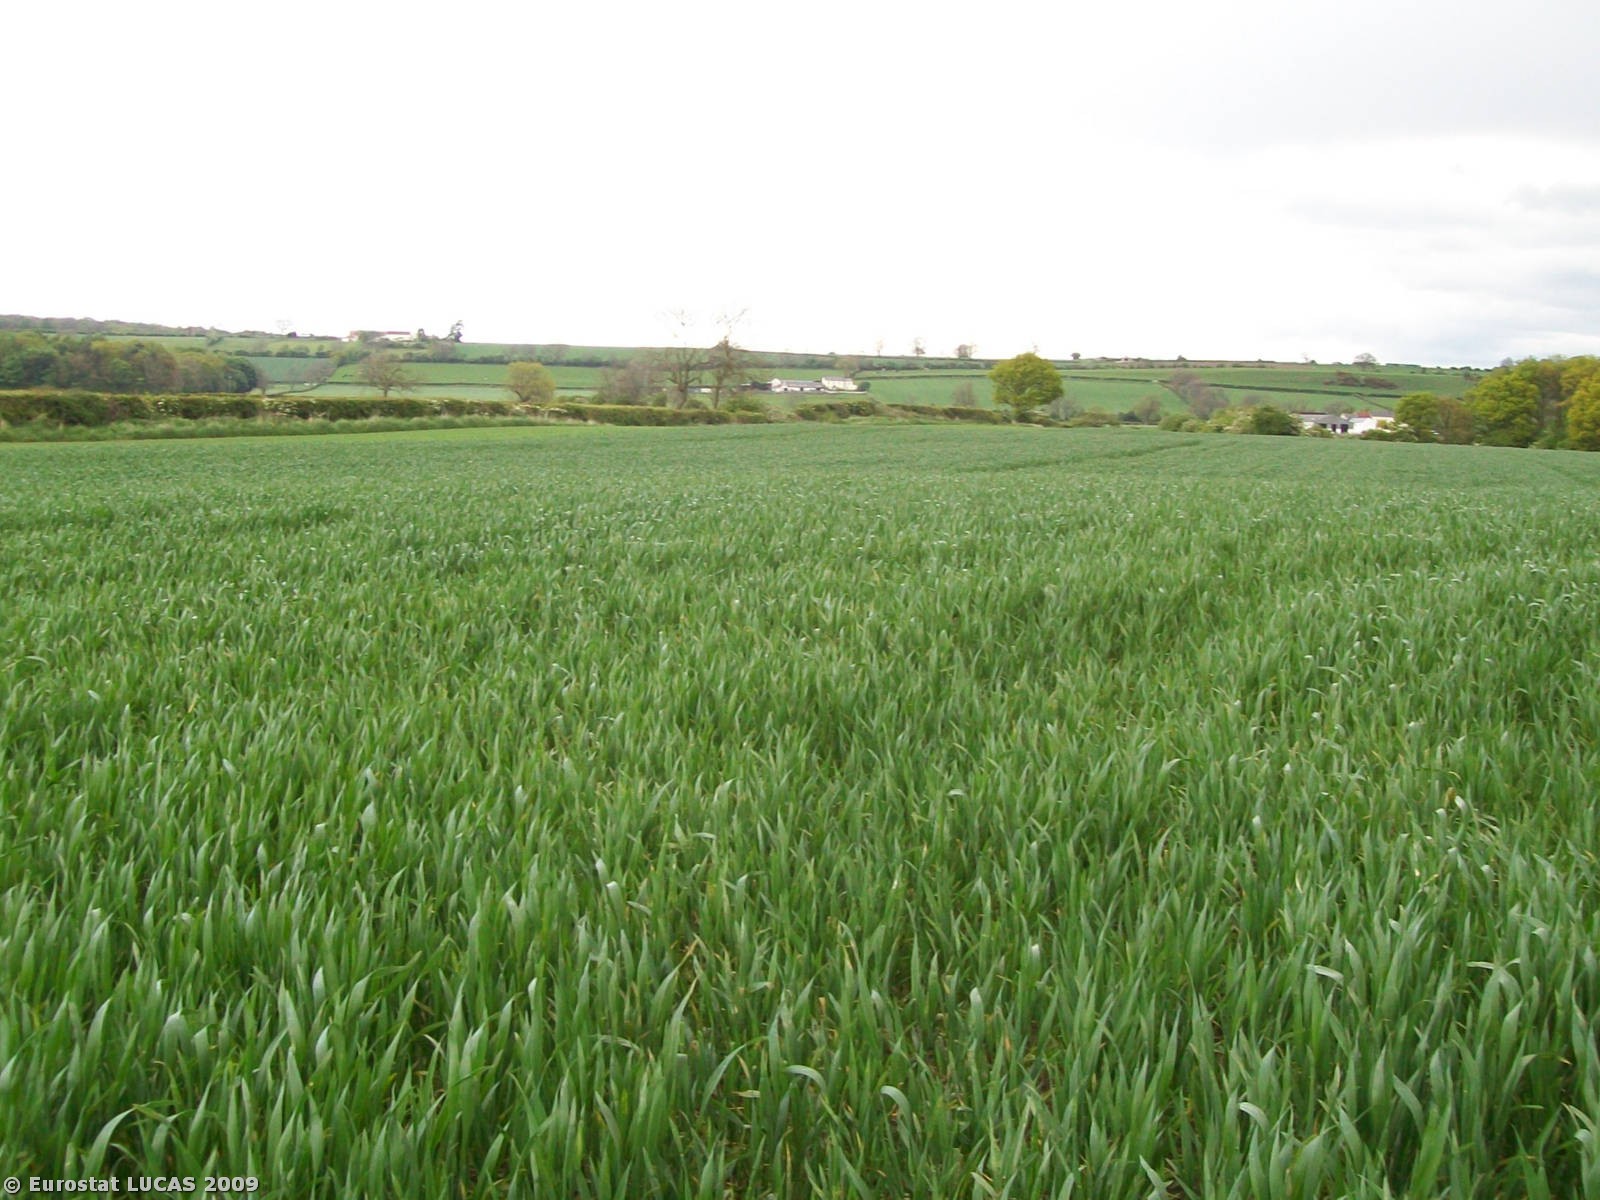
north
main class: Cropland
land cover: Barley
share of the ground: < 10 %
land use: Agriculture (excluding fallow land and kitchen gardens)
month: May
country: GB
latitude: 54.5804
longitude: -1.6700
